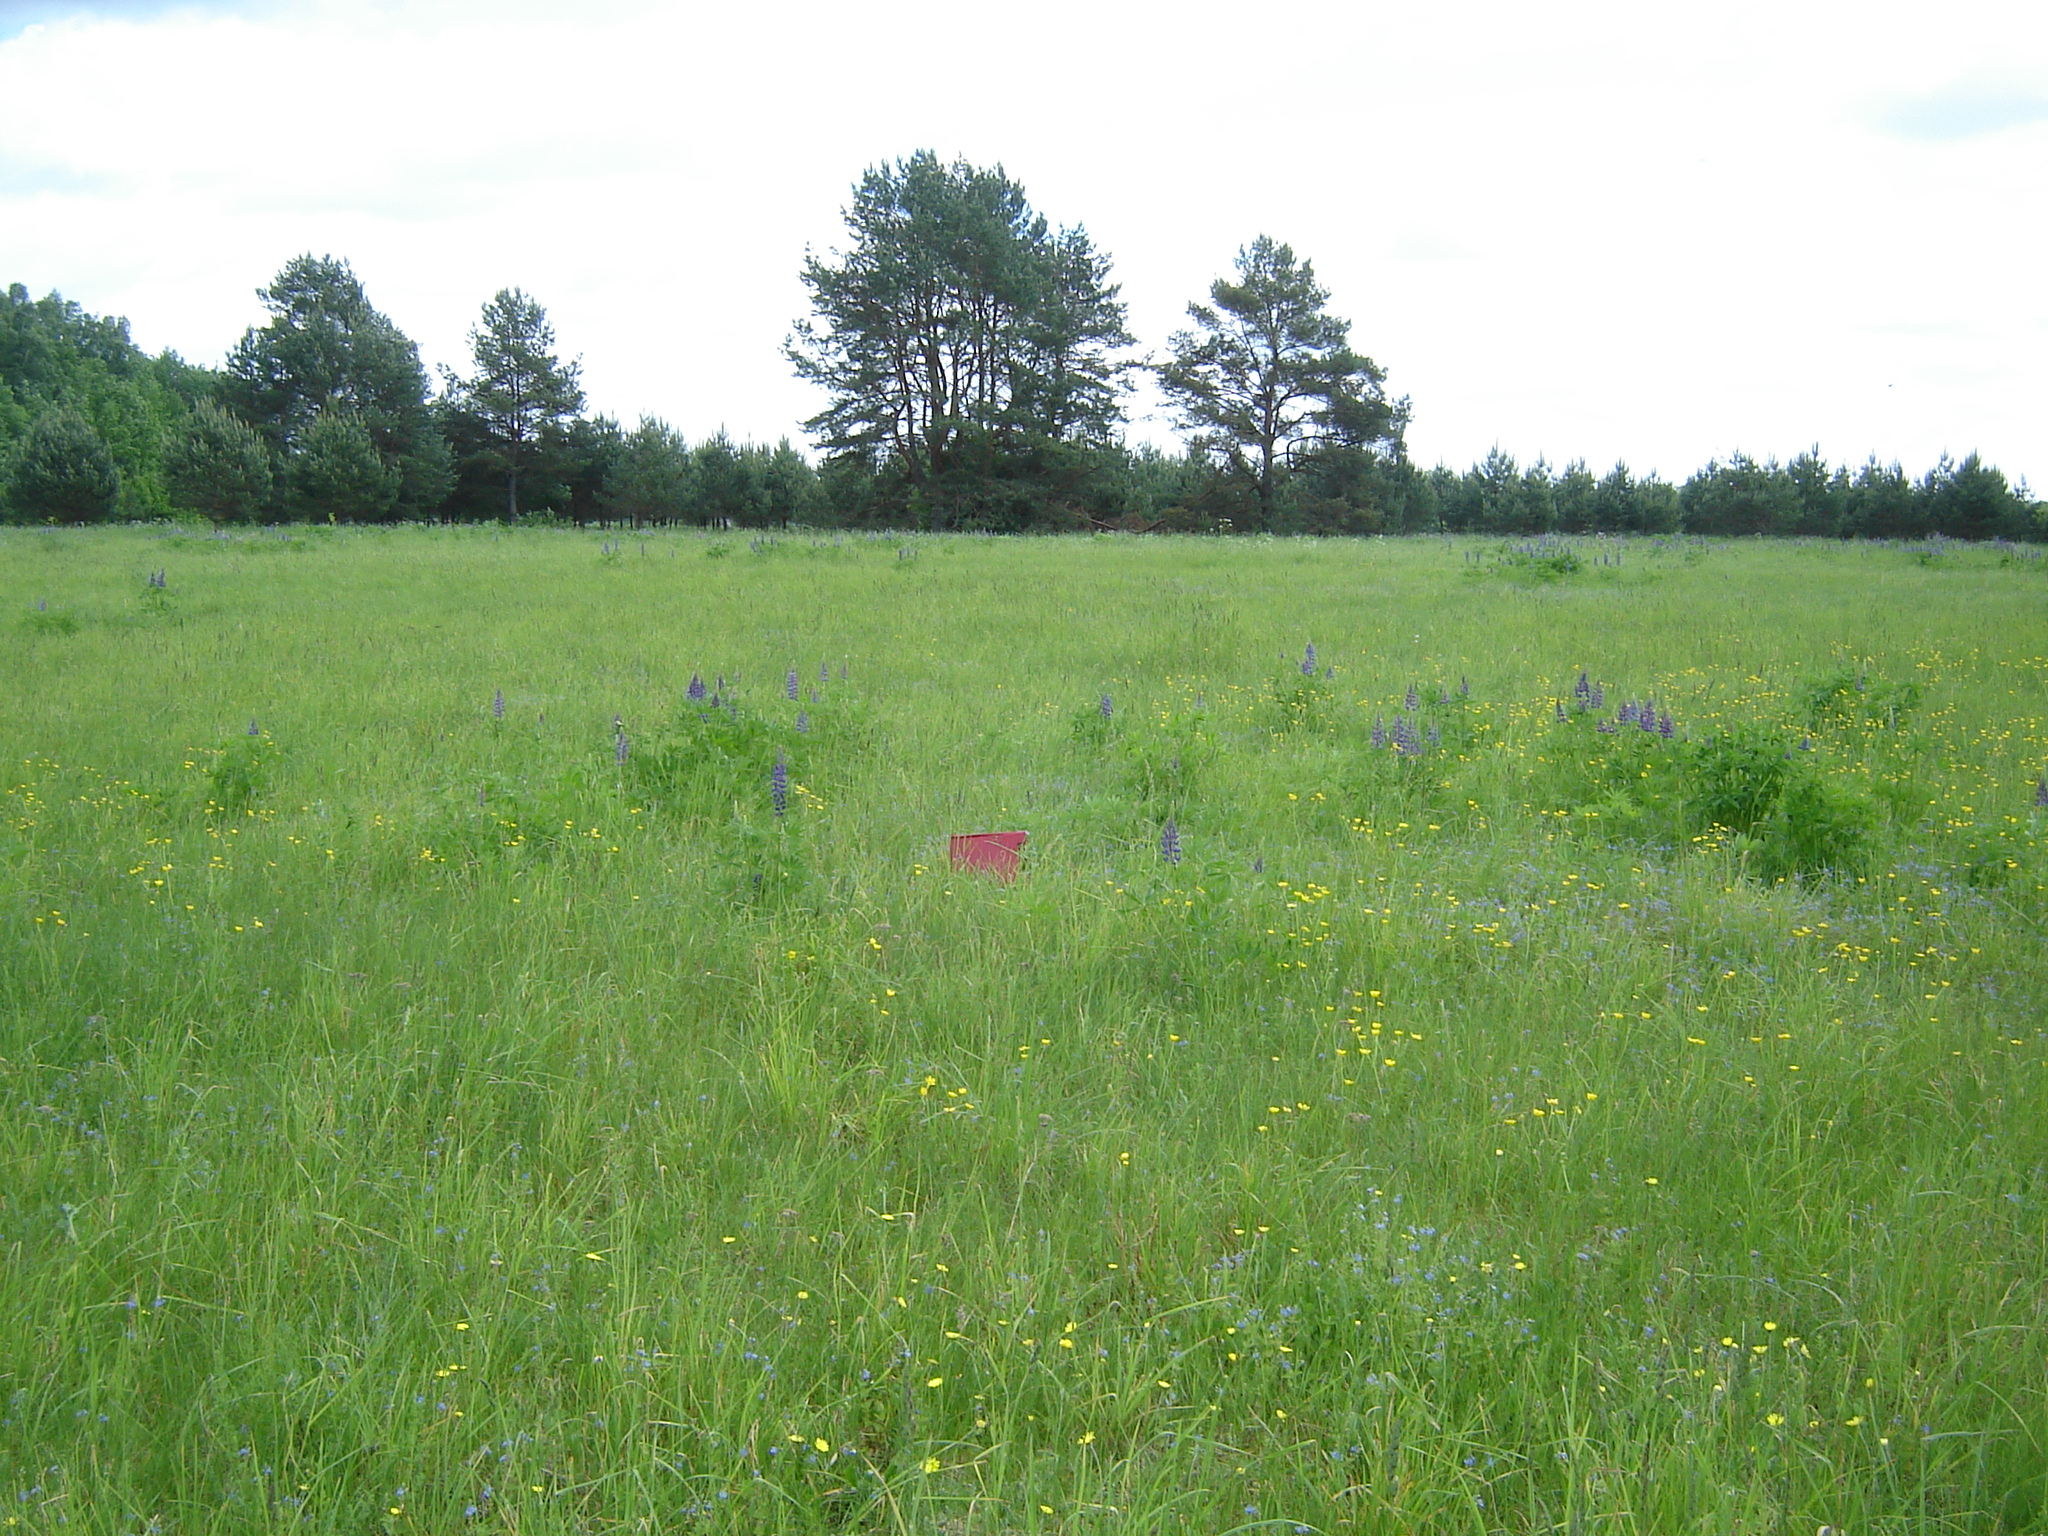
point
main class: Grassland
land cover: Grassland without tree/shrub cover
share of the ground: > 75 %
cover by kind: herbaceous plants 100 %
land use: Agriculture (excluding fallow land and kitchen gardens)
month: June
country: LT
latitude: 55.6350
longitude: 25.5496
